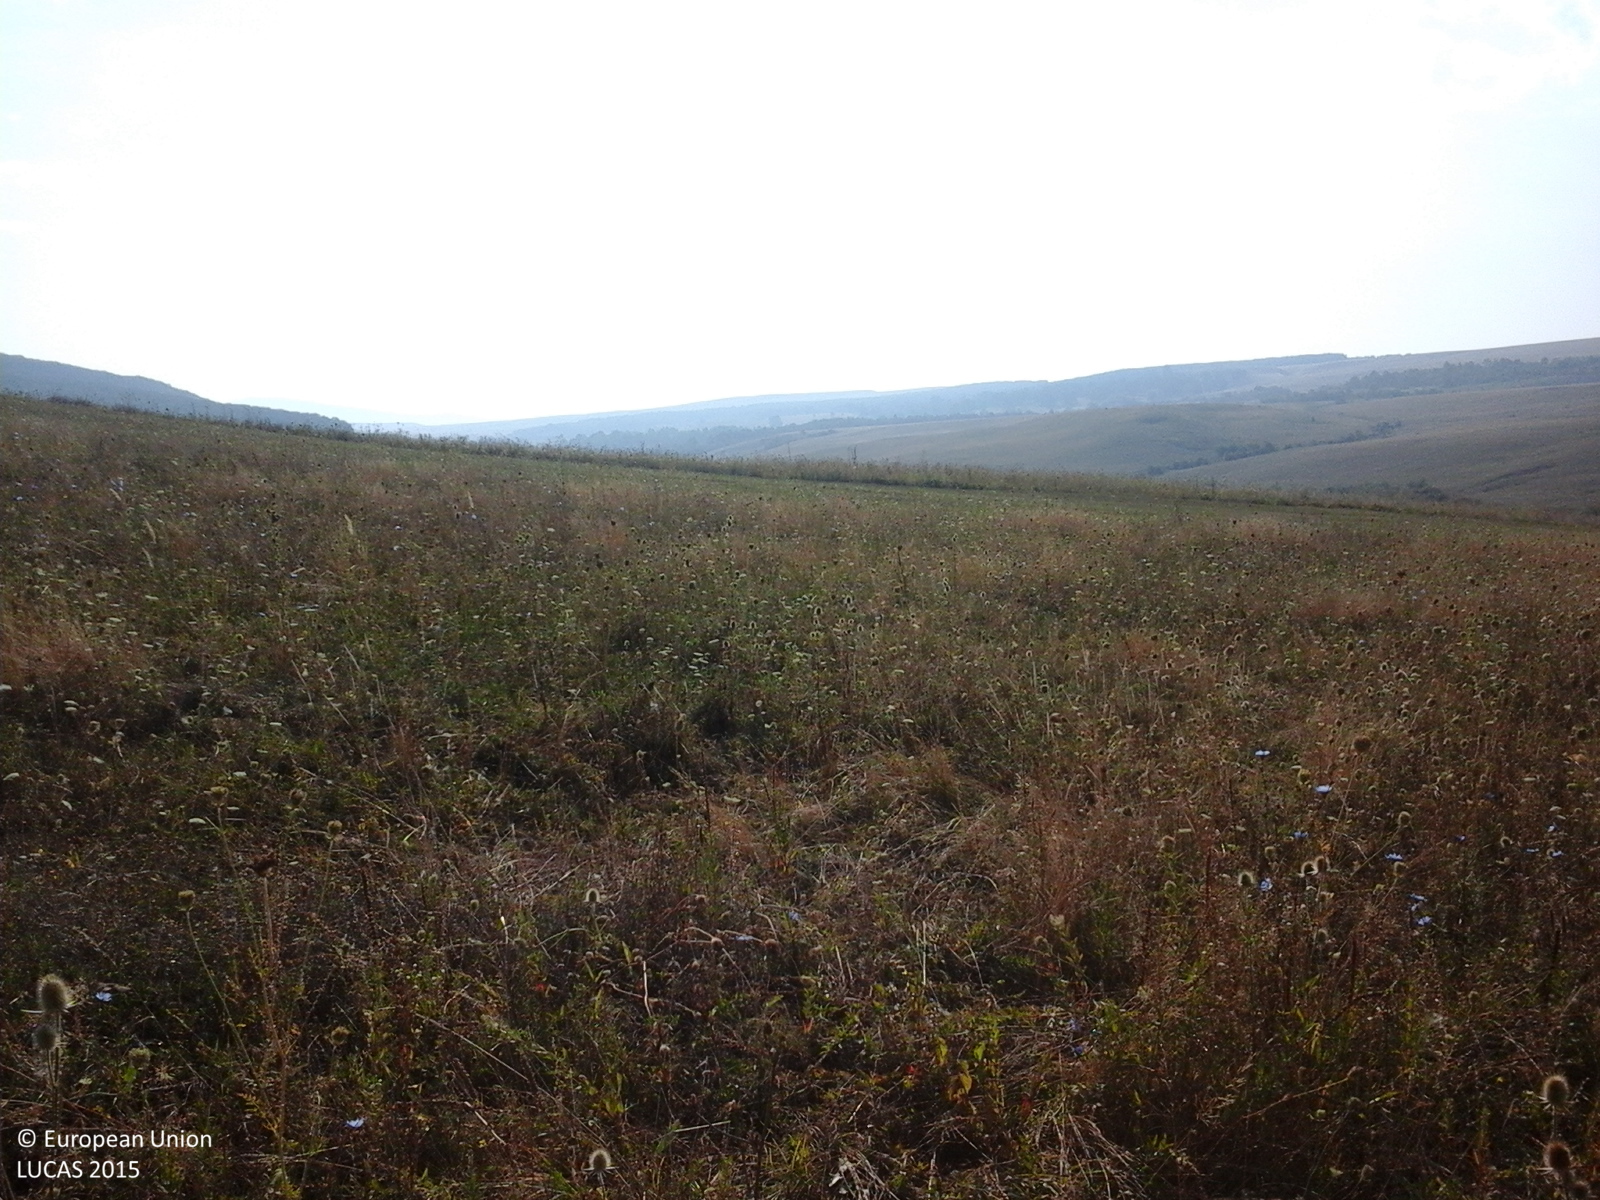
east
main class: Grassland
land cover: Grassland without tree/shrub cover
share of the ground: > 75 %
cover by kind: herbaceous plants 100 %
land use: Agriculture (excluding fallow land and kitchen gardens)
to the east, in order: Grassland without tree/shrub cover
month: September
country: RO
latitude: 47.0388
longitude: 24.5014
